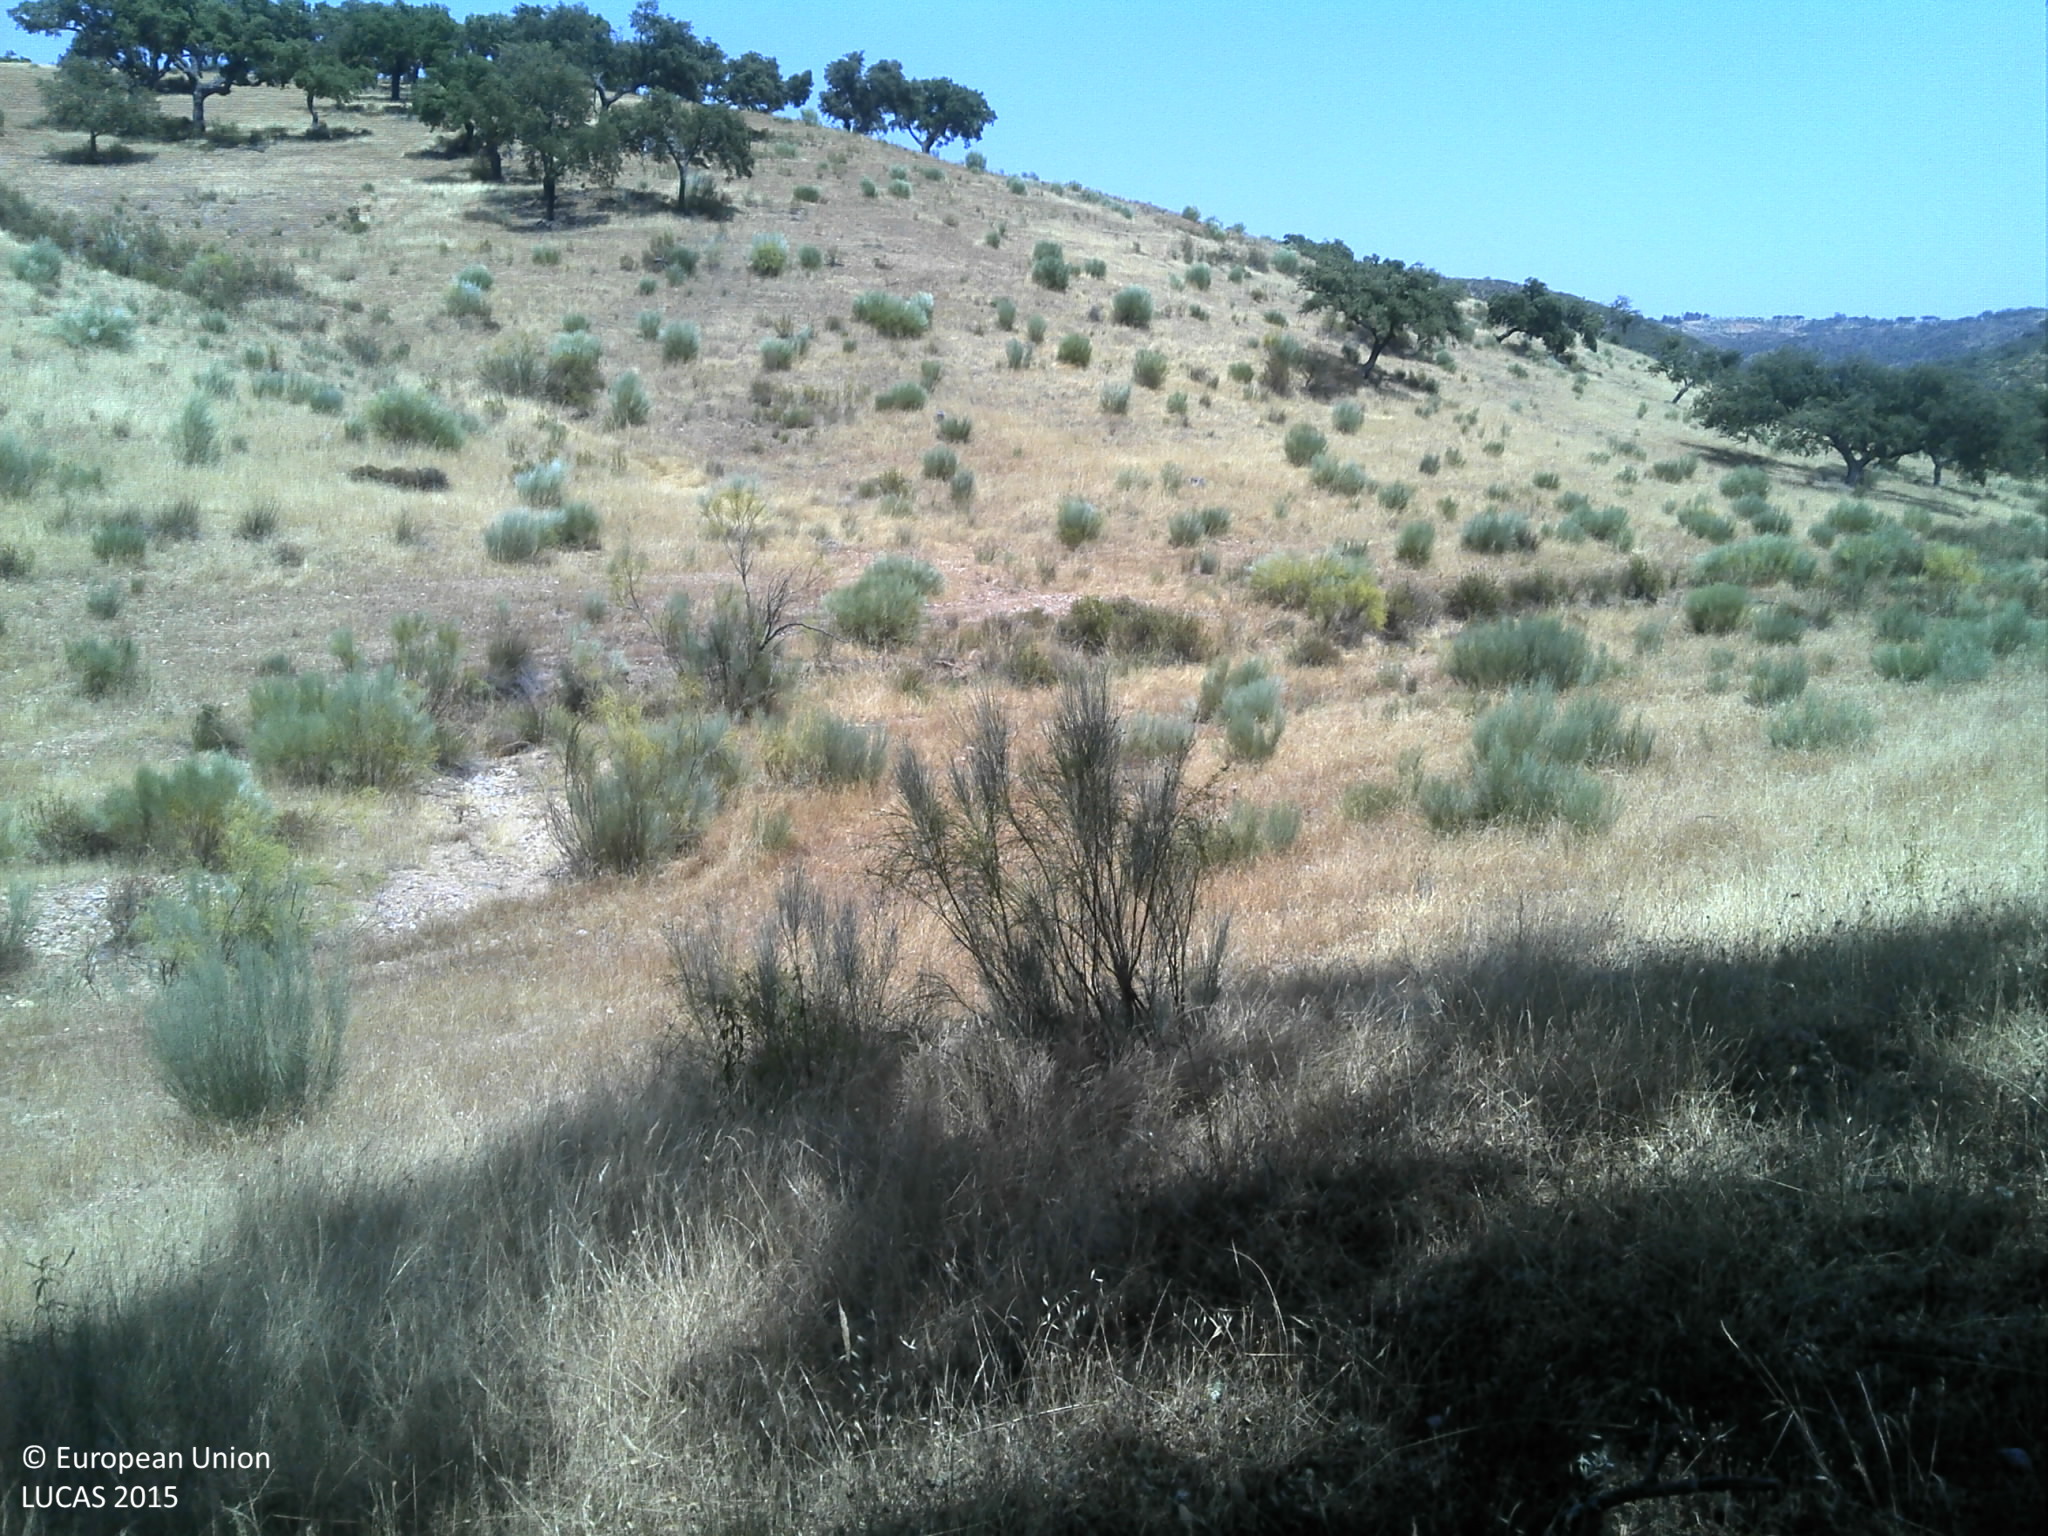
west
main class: Woodland
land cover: Broadleaved woodland
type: broadleaved evergreen forest
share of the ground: 25 - 50 %
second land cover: Grassland without tree/shrub cover
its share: 50 - 75 %
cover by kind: herbaceous plants 60 %, broadleaved forest trees 30 %, shrubs 5 %, unconsolidated bare surface 5 %
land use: Forestry
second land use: Agriculture (excluding fallow land and kitchen gardens)
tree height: > 5 m
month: June
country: PT
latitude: 39.7439
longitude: -7.2344
